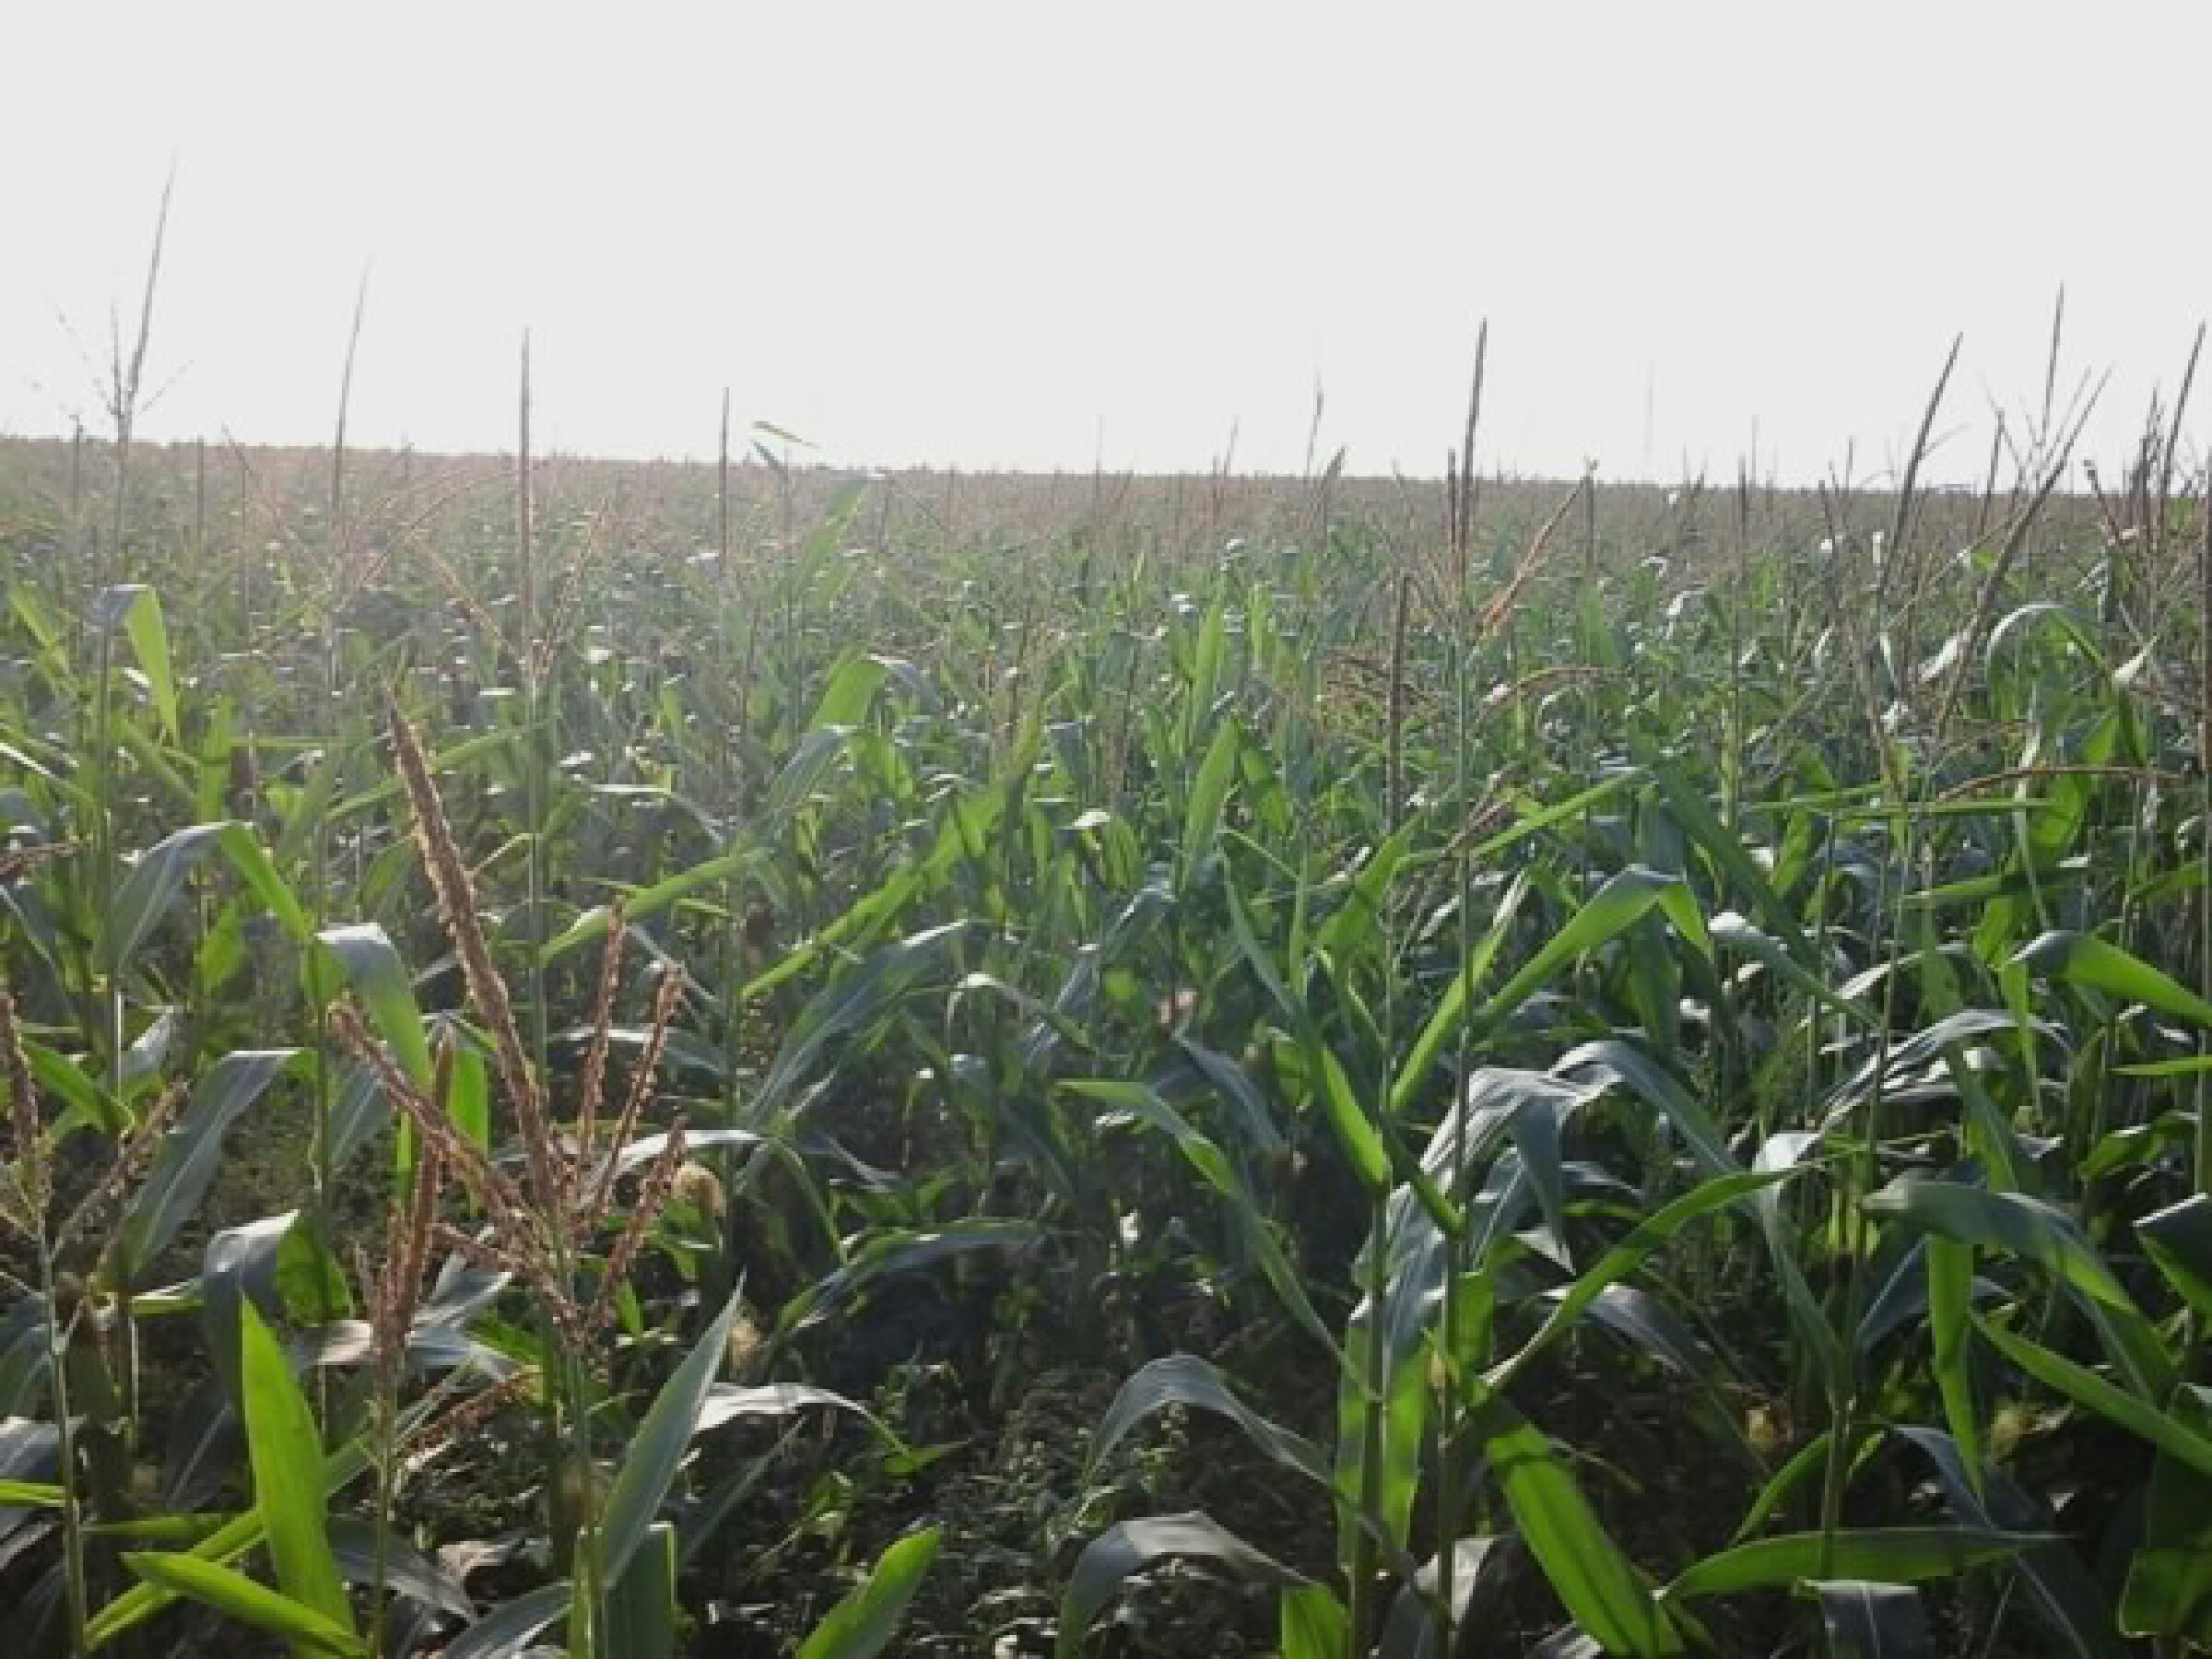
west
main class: Cropland
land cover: Maize
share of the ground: > 75 %
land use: Agriculture (excluding fallow land and kitchen gardens)
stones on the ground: < 10 %
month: August
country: HU
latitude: 48.0565
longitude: 19.4013
